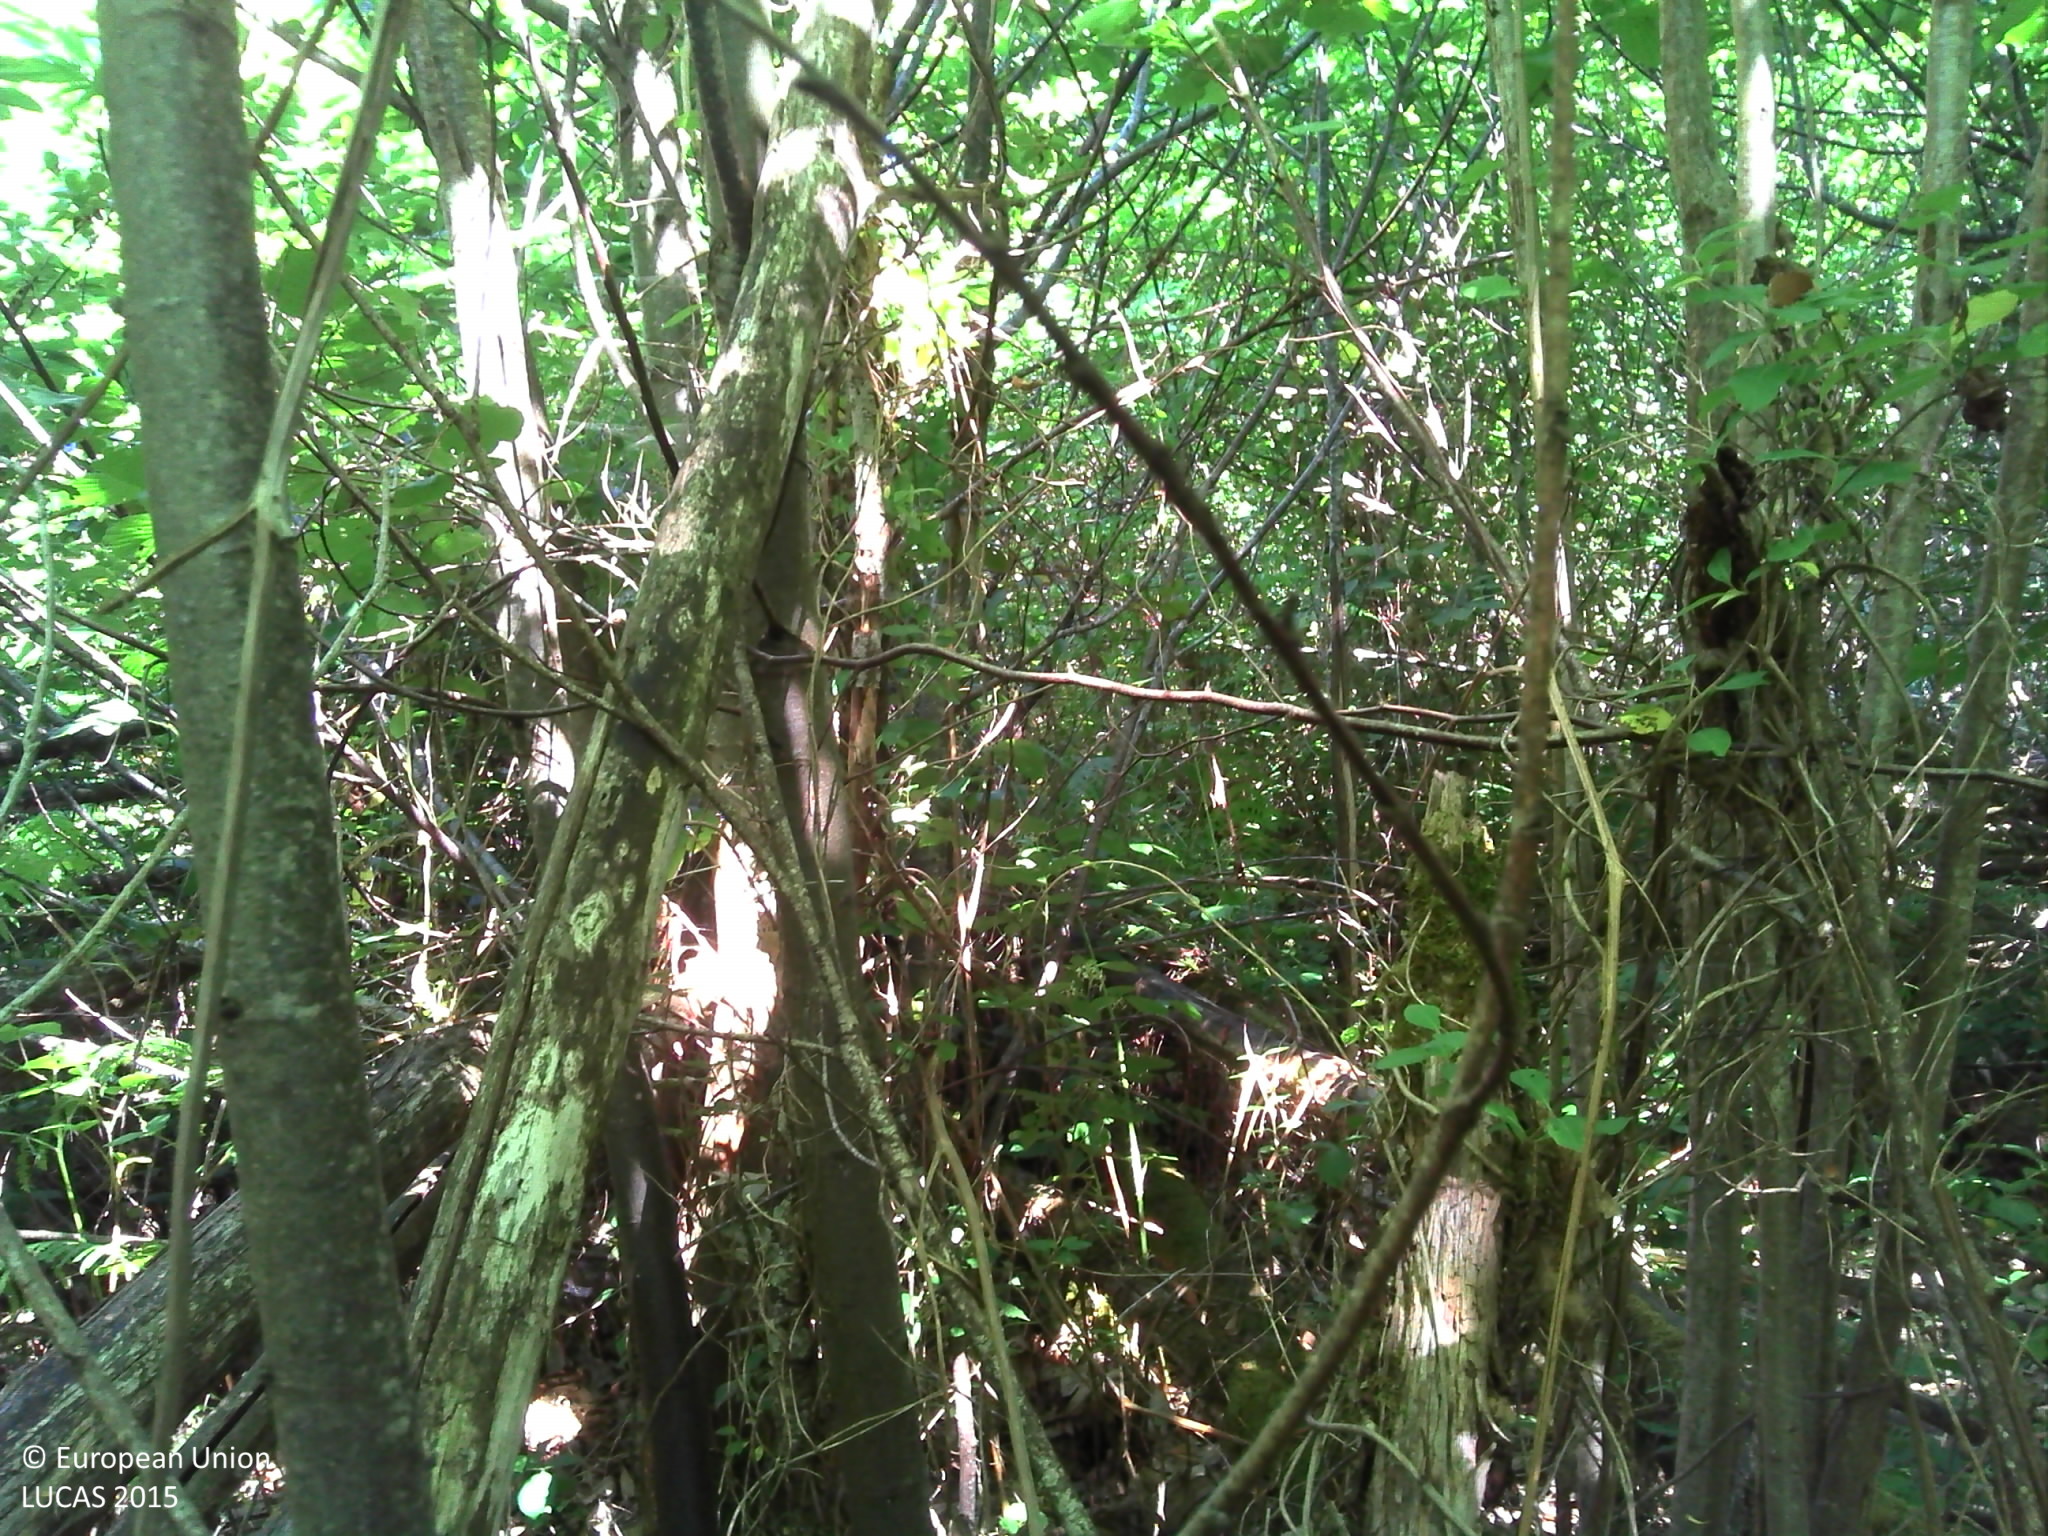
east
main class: Woodland
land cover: Broadleaved woodland
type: thermophilous deciduous forest
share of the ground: > 75 %
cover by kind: broadleaved forest trees 80 %, shrubs 15 %, herbaceous plants 5 %
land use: Semi-natural and natural areas not in use
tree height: > 5 m
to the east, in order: Broadleaved woodland; Grass margins; Paved roads, cycling and walking lanes; Grass margins; Fences; Grassland without tree/shrub cover; Fences; Broadleaved woodland
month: June
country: FR
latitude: 45.7610
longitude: 0.6656
